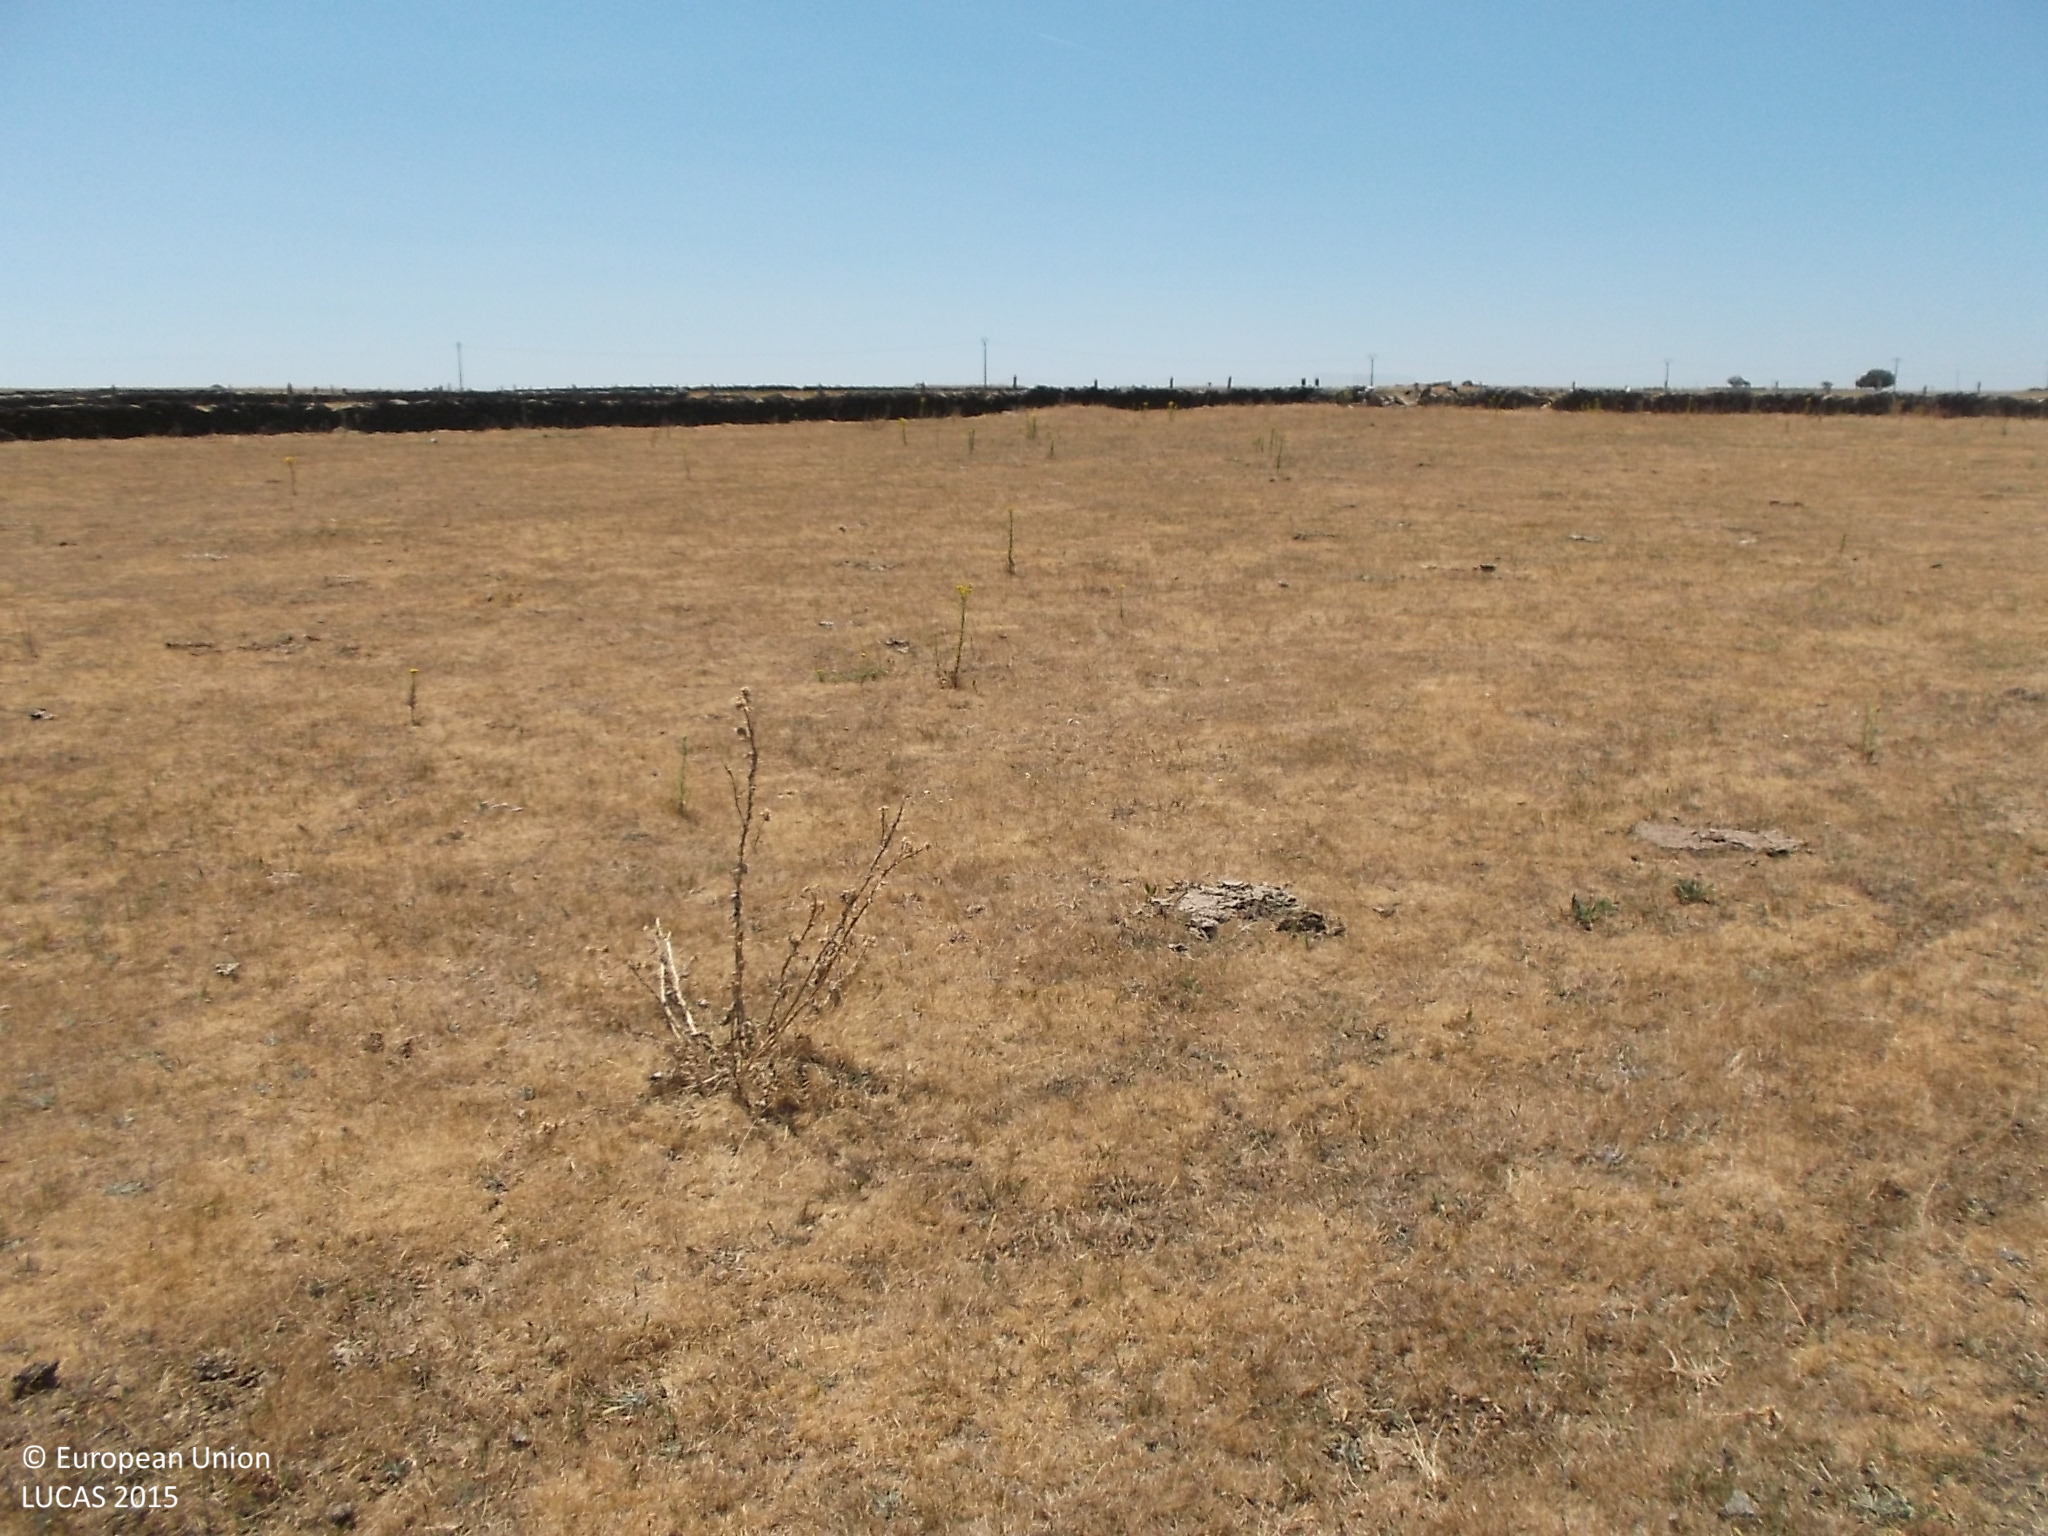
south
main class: Grassland
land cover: Grassland without tree/shrub cover
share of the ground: > 75 %
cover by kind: herbaceous plants 100 %
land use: Agriculture (excluding fallow land and kitchen gardens)
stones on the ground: < 10 %
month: July
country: ES
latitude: 40.7172
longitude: -6.7285
